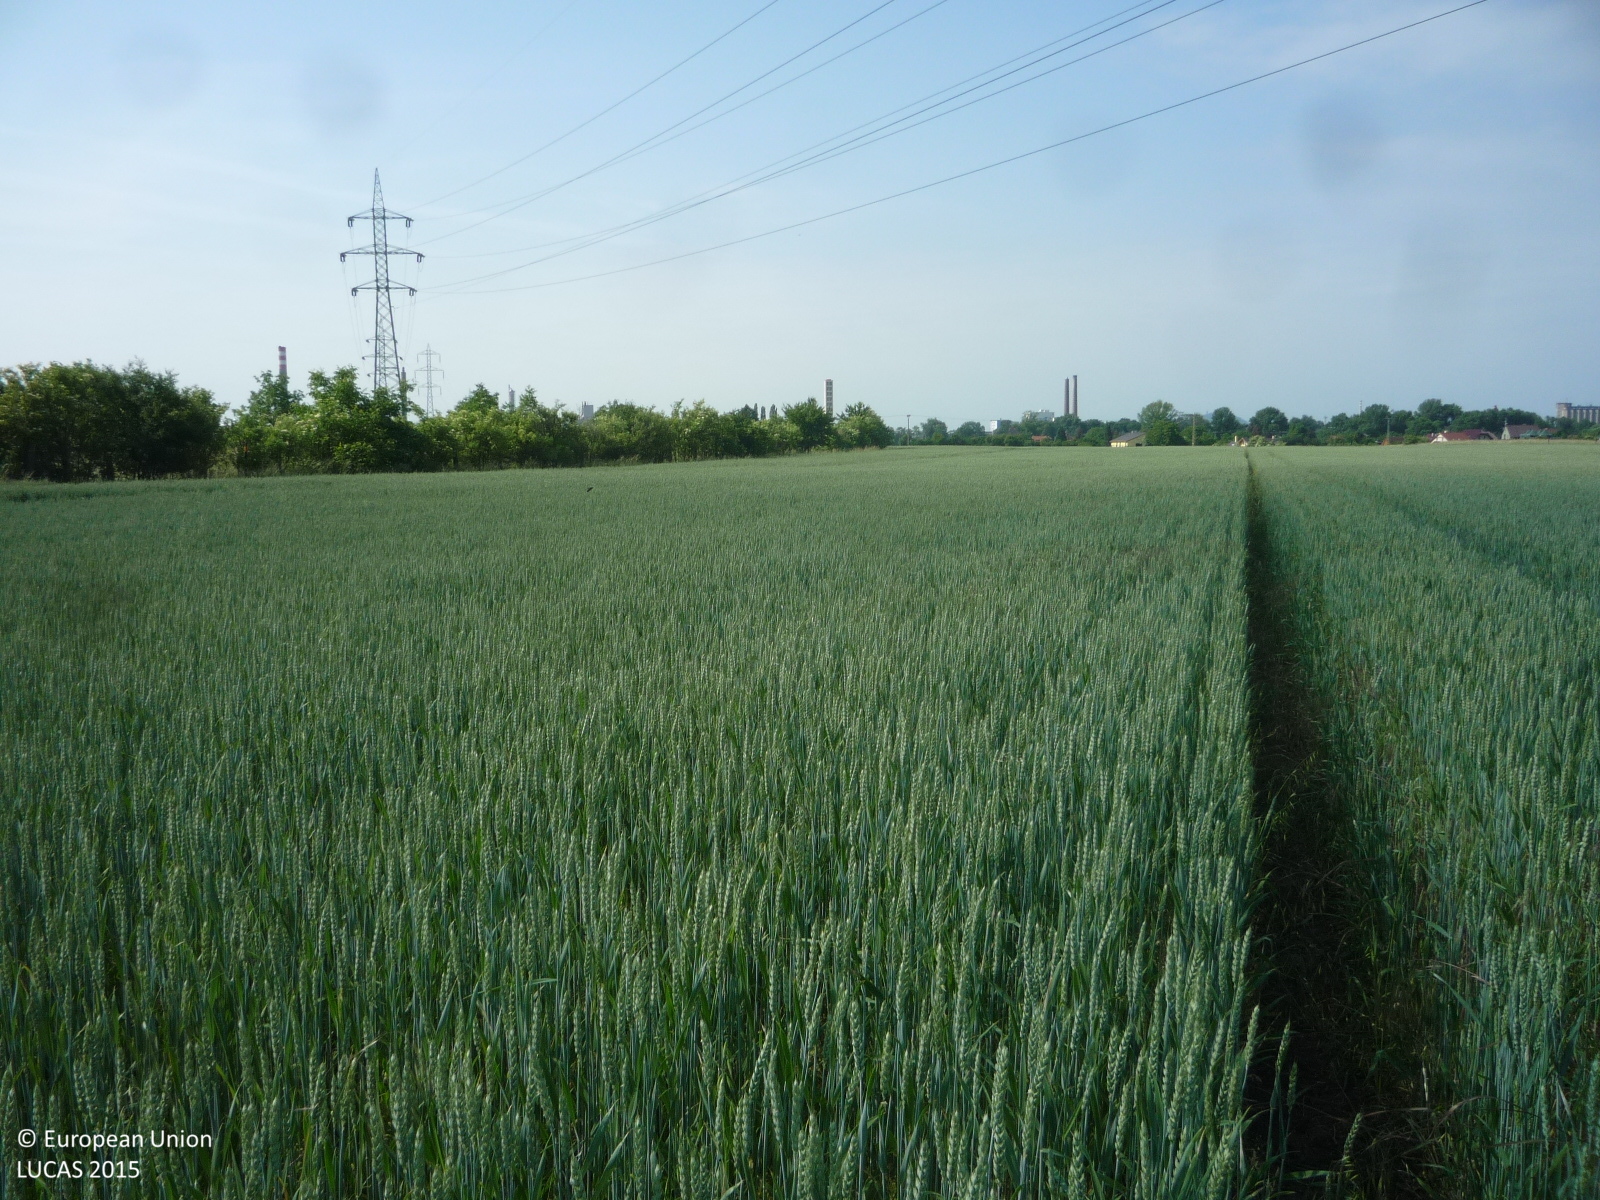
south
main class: Cropland
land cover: Common wheat
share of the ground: > 75 %
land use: Agriculture (excluding fallow land and kitchen gardens)
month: June
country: CZ
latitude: 50.5254
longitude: 14.0777
